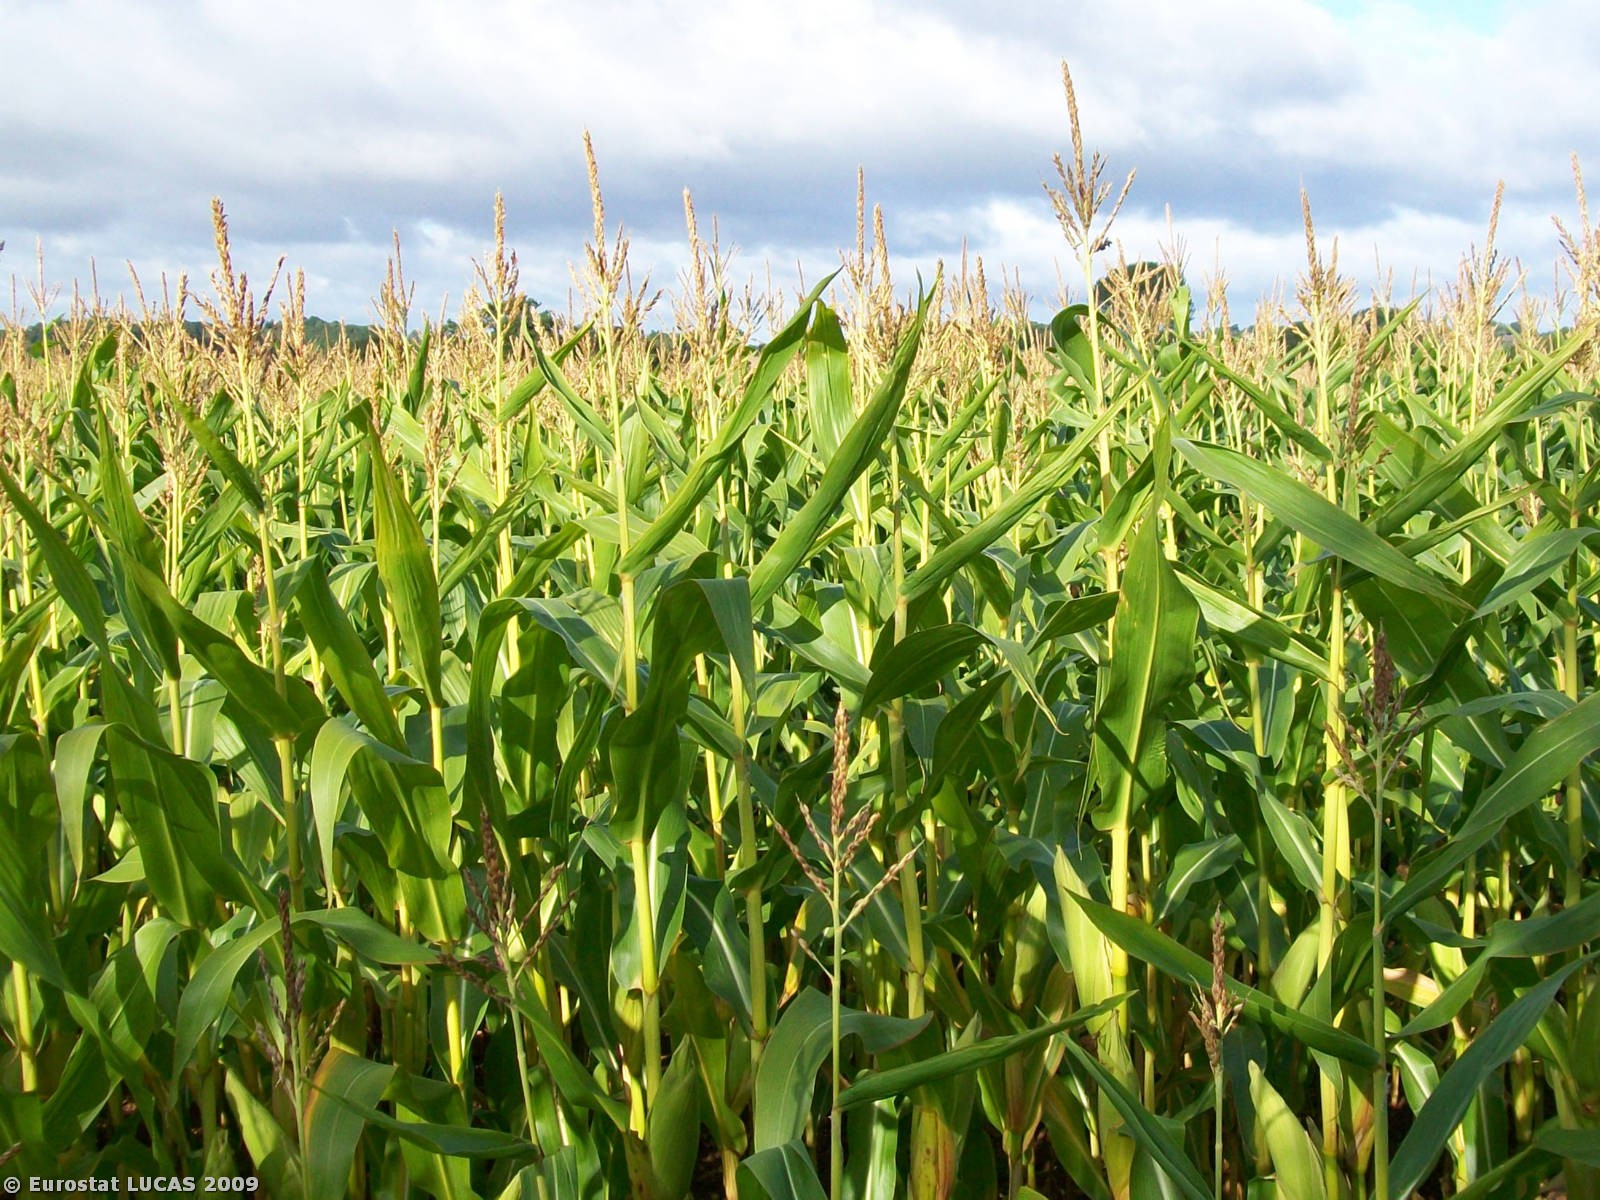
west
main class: Cropland
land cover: Maize
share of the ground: 25 - 50 %
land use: Agriculture (excluding fallow land and kitchen gardens)
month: September
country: GB
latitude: 52.1146
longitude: -2.4937
